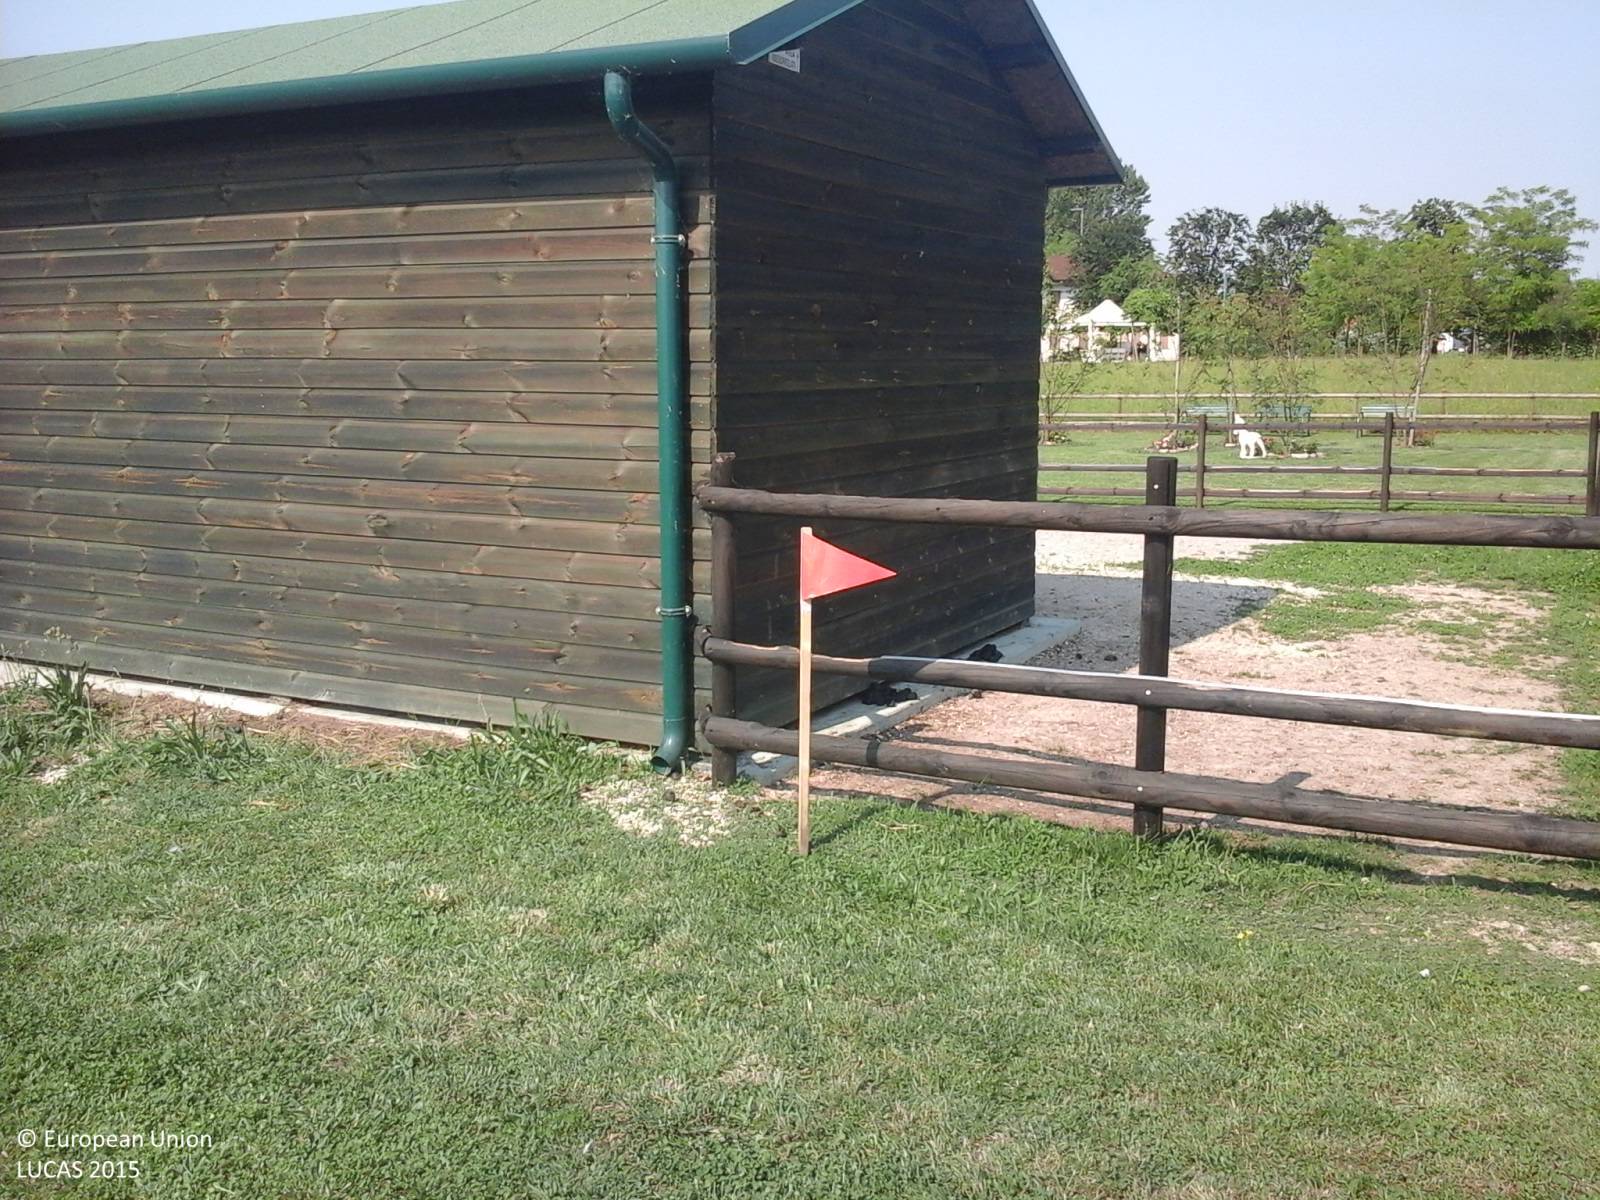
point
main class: Grassland
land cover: Grassland without tree/shrub cover
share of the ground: > 75 %
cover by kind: herbaceous plants 100 %
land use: Residential
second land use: Agriculture (excluding fallow land and kitchen gardens)
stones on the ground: < 10 %
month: June
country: IT
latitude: 45.8700
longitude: 12.5602
